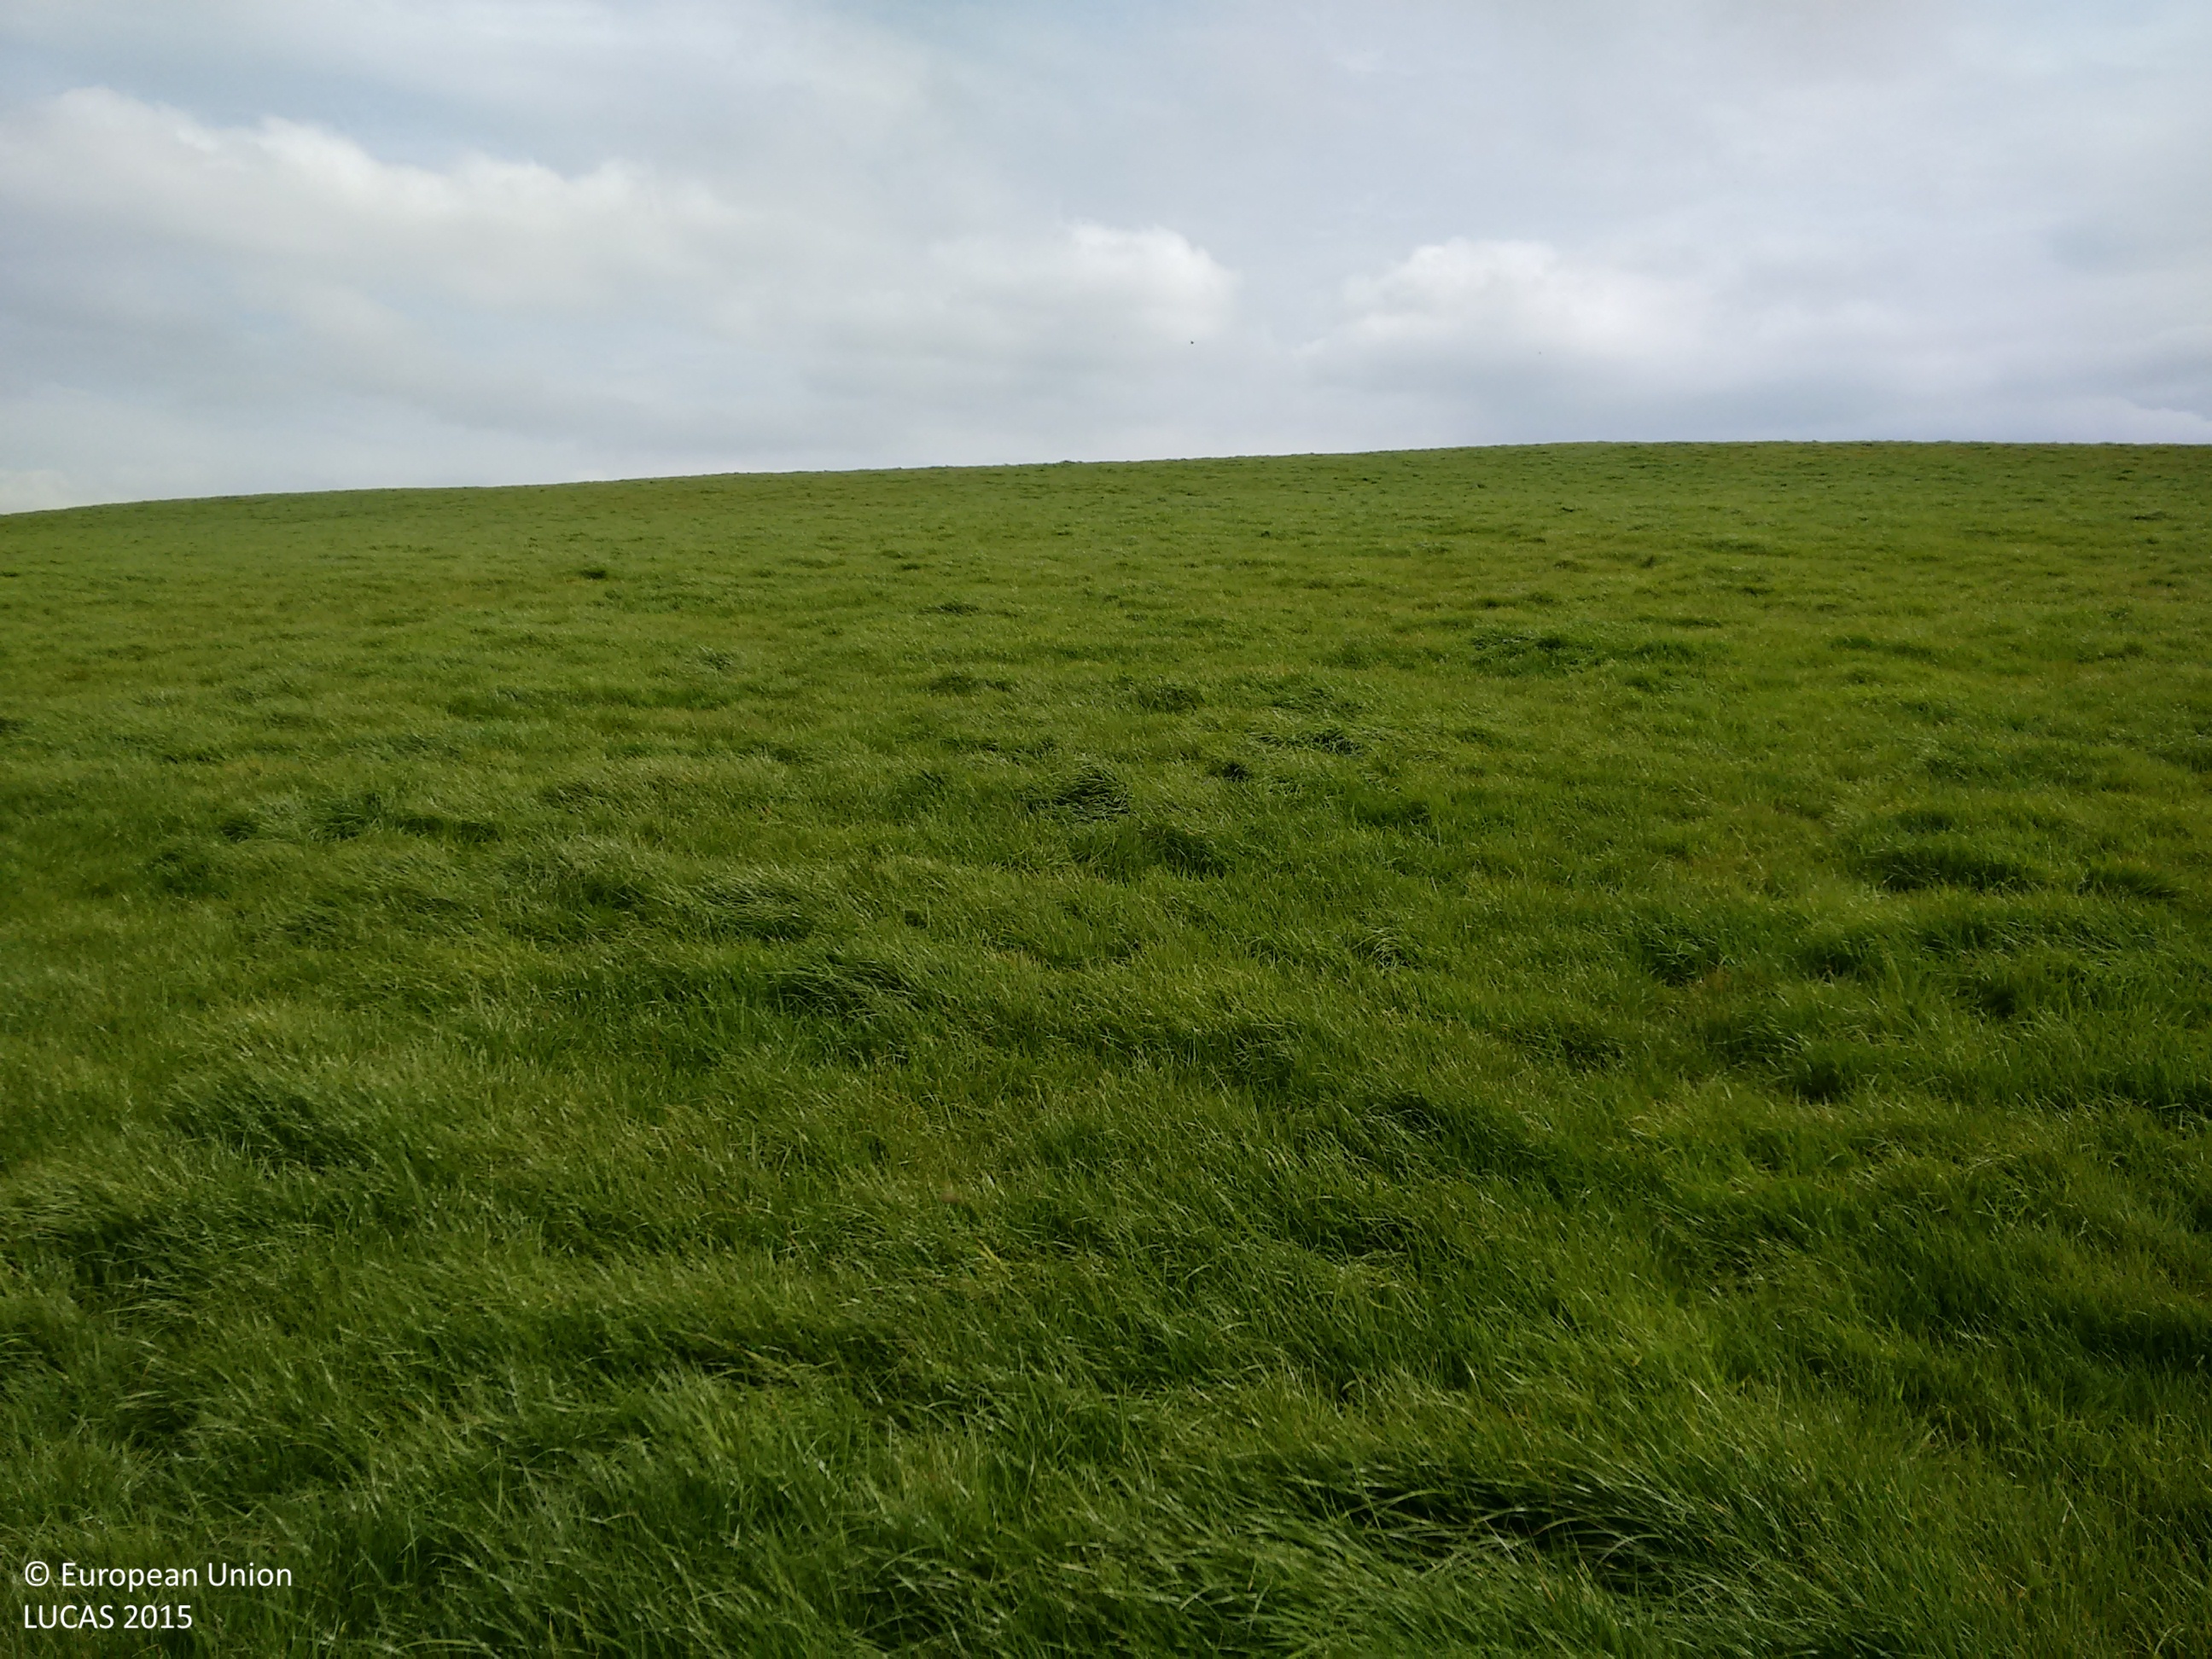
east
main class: Grassland
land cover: Grassland without tree/shrub cover
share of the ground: > 75 %
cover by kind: herbaceous plants 100 %
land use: Agriculture (excluding fallow land and kitchen gardens)
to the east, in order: Grassland without tree/shrub cover; Fences; Grass margins; Rape and turnip rape; Fences; Grassland without tree/shrub cover
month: May
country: GB
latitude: 55.6677
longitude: -2.2828
